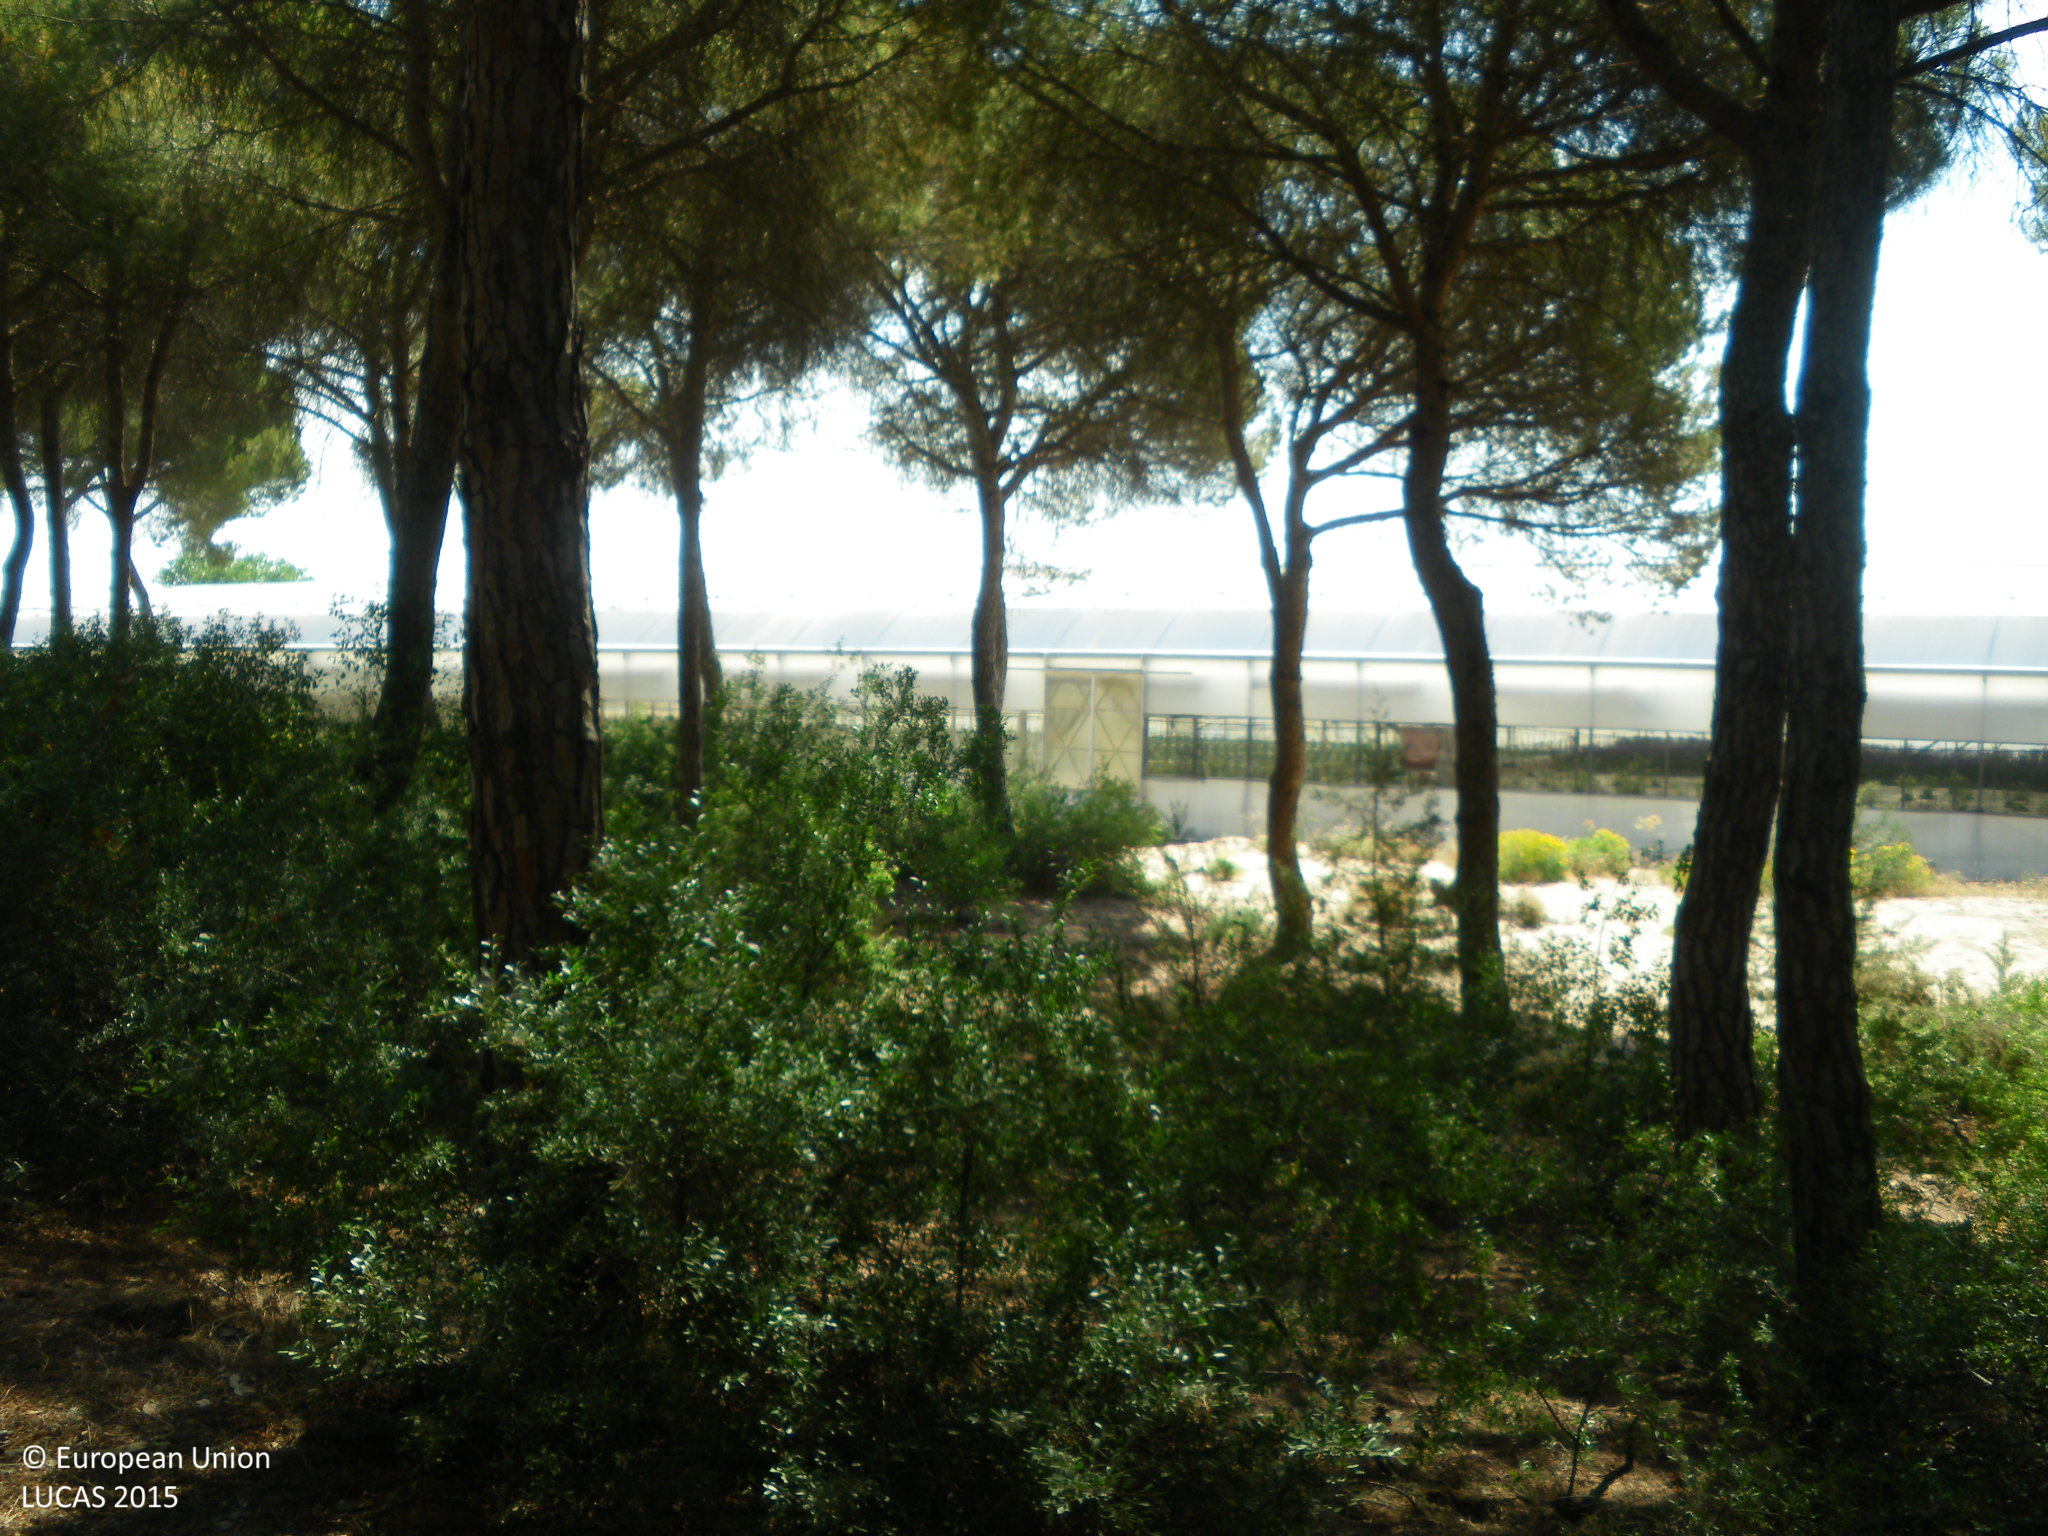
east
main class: Woodland
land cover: Pine dominated coniferous woodland
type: coniferous forest of the mediterranean region
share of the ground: > 75 %
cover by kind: coniferous forest trees 90 %, unconsolidated bare surface 10 %
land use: Semi-natural and natural areas not in use
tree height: > 5 m
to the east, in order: Pine dominated coniferous woodland; Other bare soil; Artificial constructions in urban areas; Other root crops; Artificial constructions in urban areas; Grassland without tree/shrub cover; Artificial constructions in urban areas; Other root crops; Spontaneously vegetated surfaces; Artificial constructions in urban areas; Grass margins; Potatoes
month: May
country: ES
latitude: 36.8061
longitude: -6.3263
